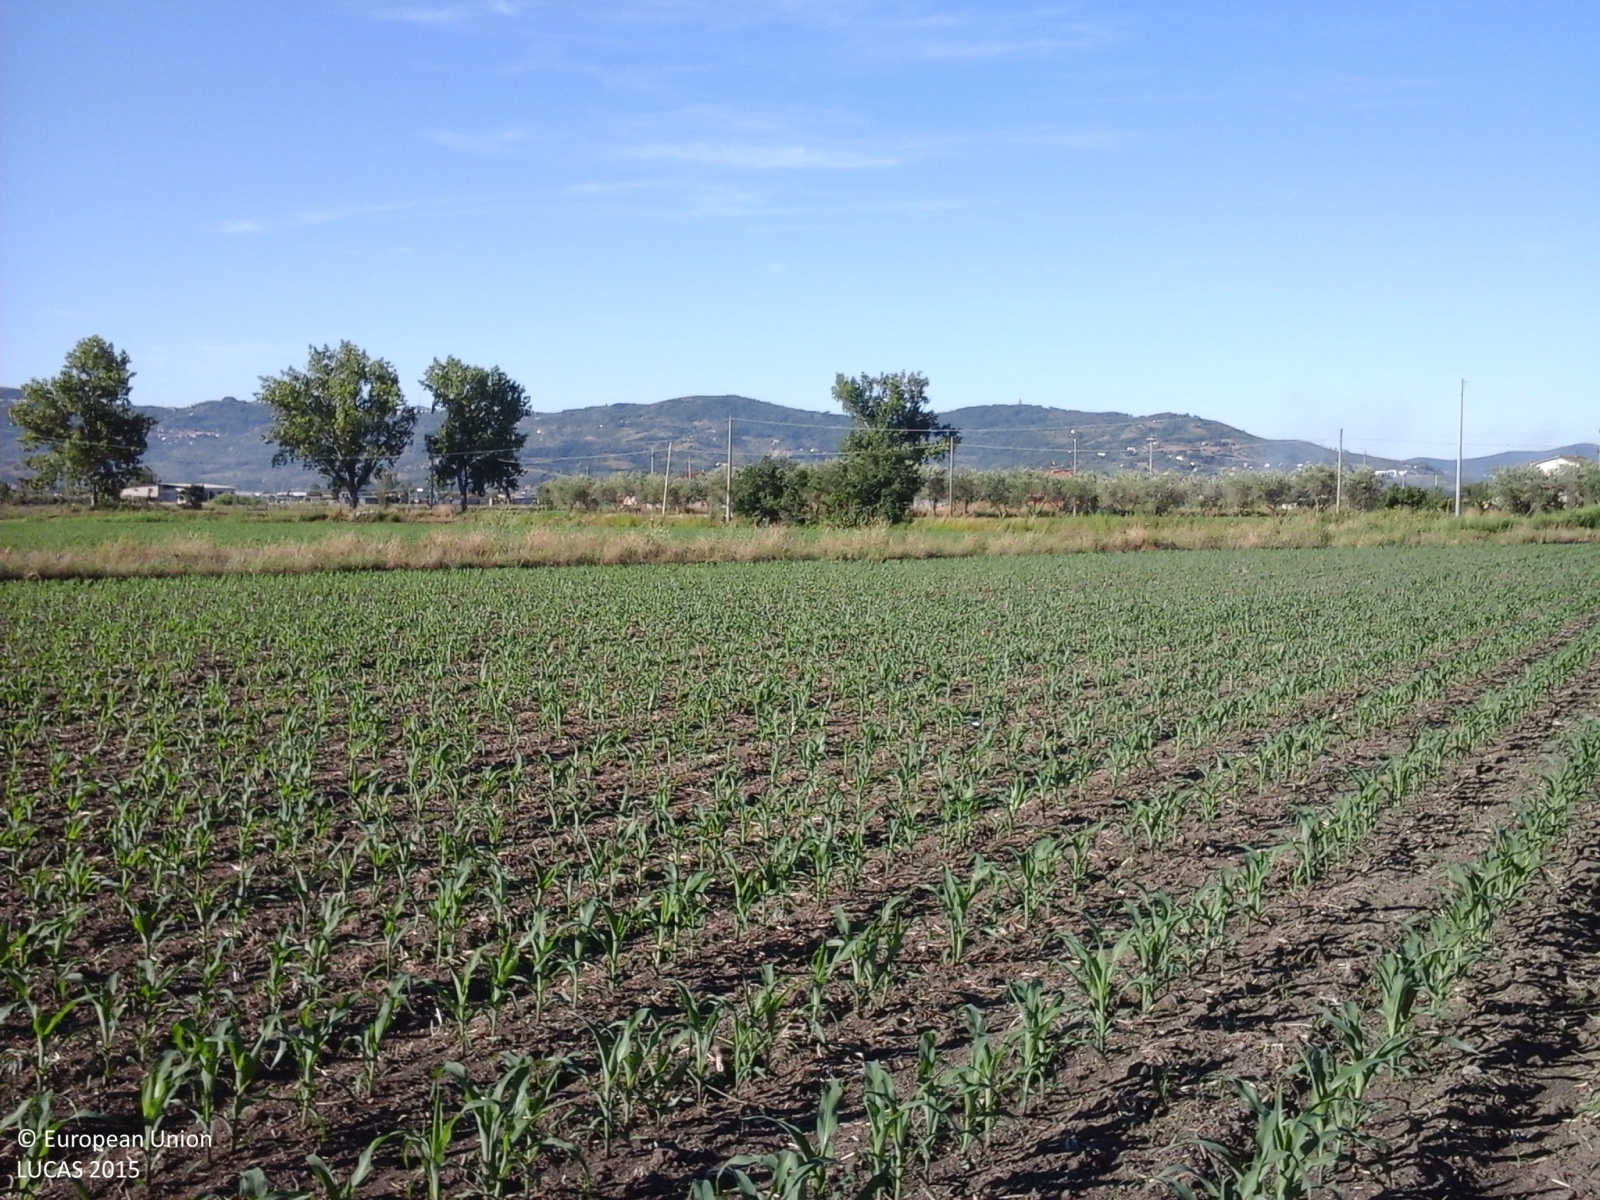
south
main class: Cropland
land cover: Maize
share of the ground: 25 - 50 %
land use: Agriculture (excluding fallow land and kitchen gardens)
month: June
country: IT
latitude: 40.4100
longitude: 15.0336
